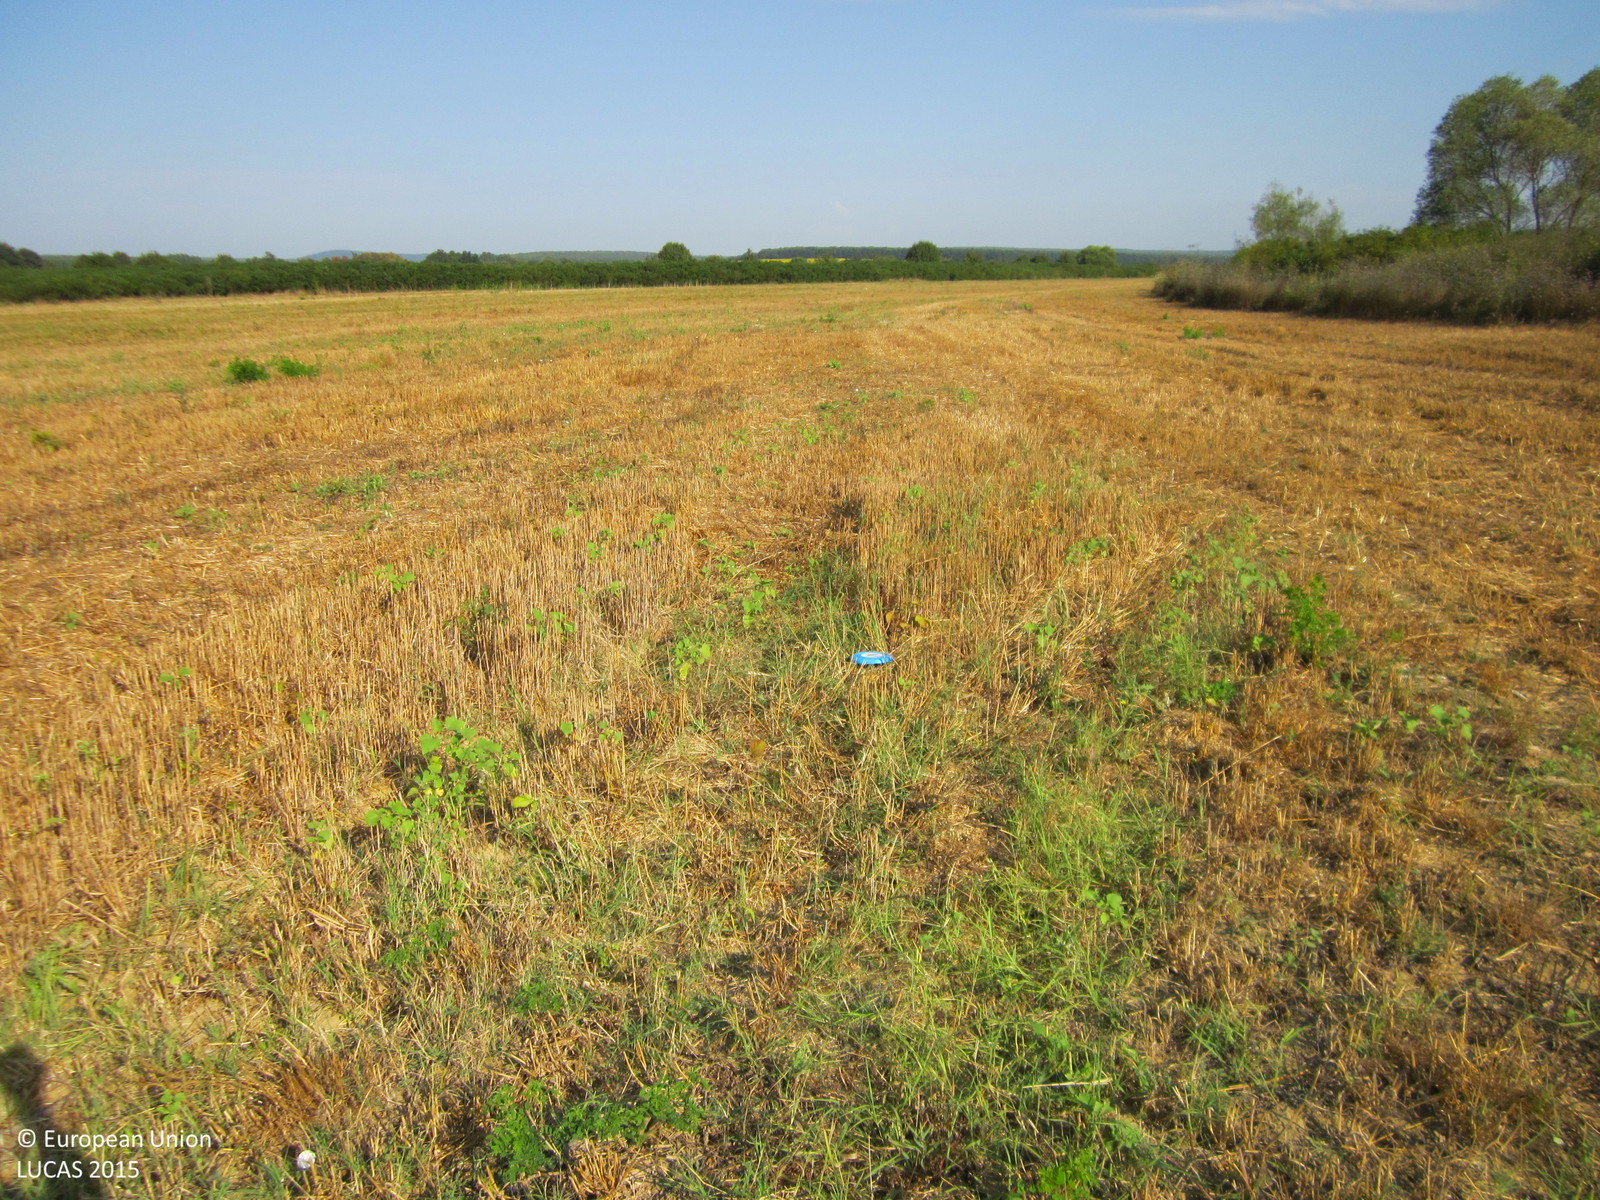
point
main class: Cropland
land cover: Common wheat
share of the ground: 50 - 75 %
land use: Agriculture (excluding fallow land and kitchen gardens)
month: August
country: BG
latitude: 42.8624
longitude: 27.8429
